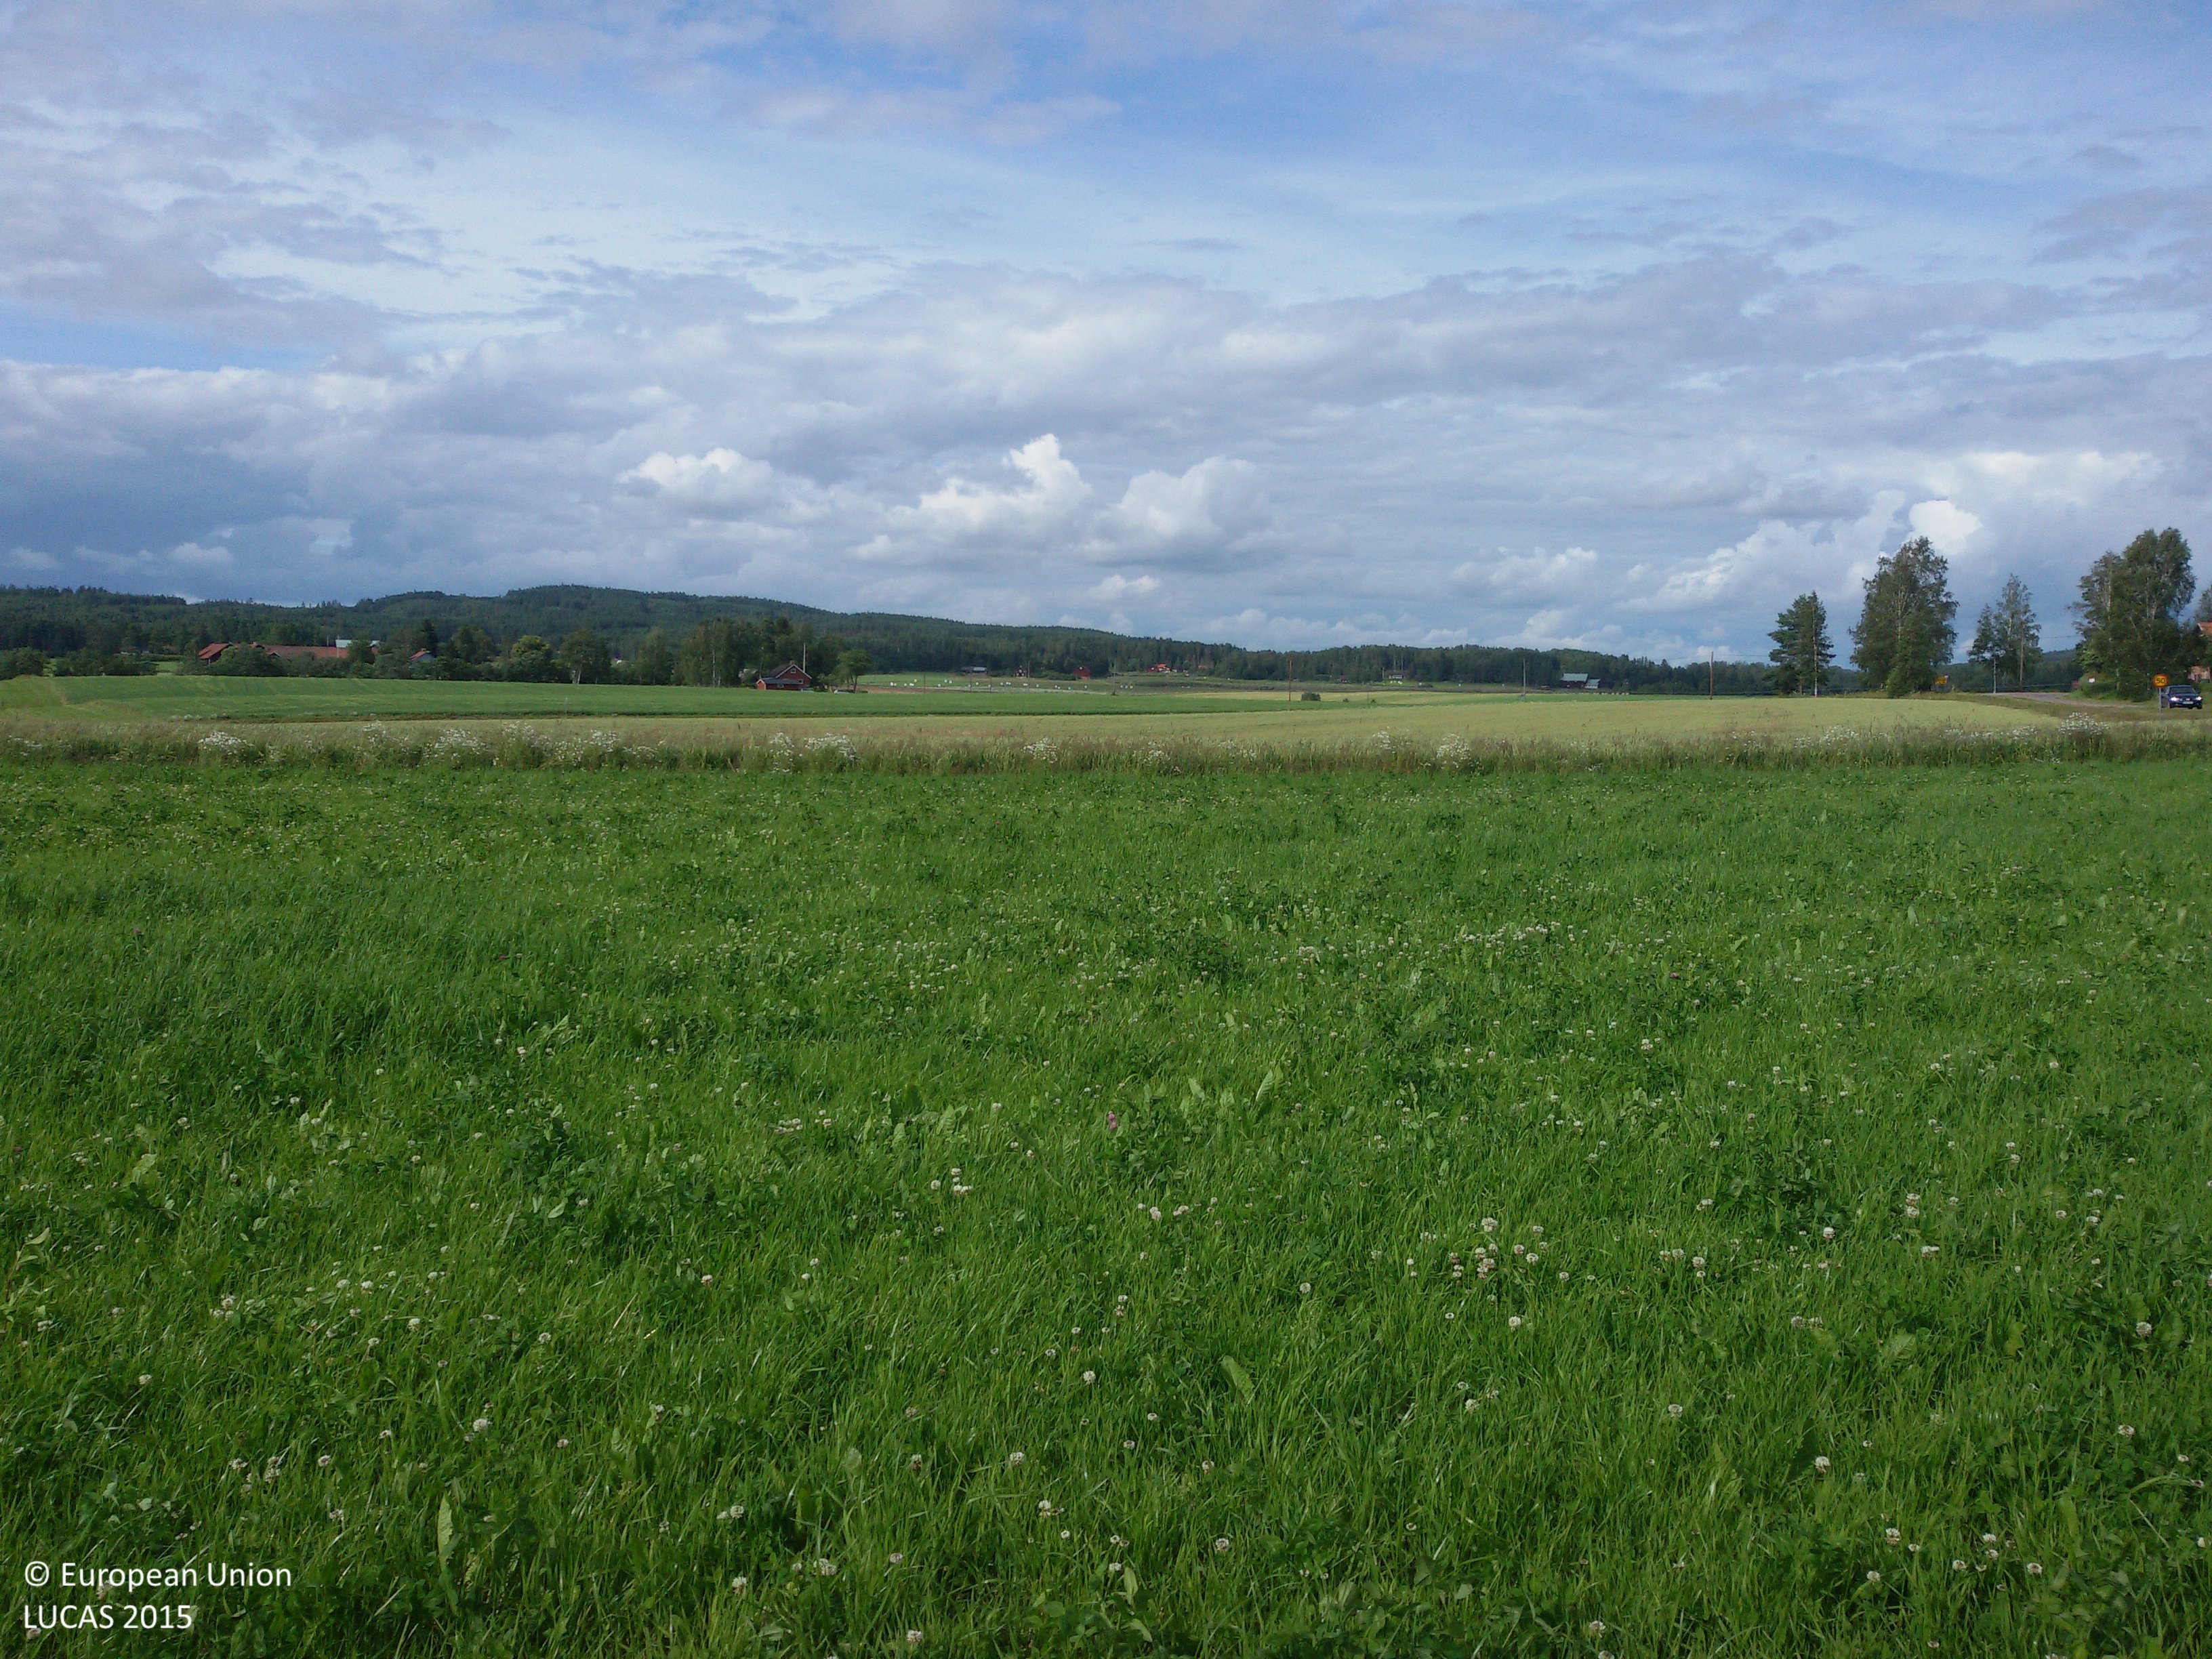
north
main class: Cropland
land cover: Other leguminous and mixtures for fodder
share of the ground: > 75 %
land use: Agriculture (excluding fallow land and kitchen gardens)
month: July
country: SE
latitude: 60.4233
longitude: 15.7820
